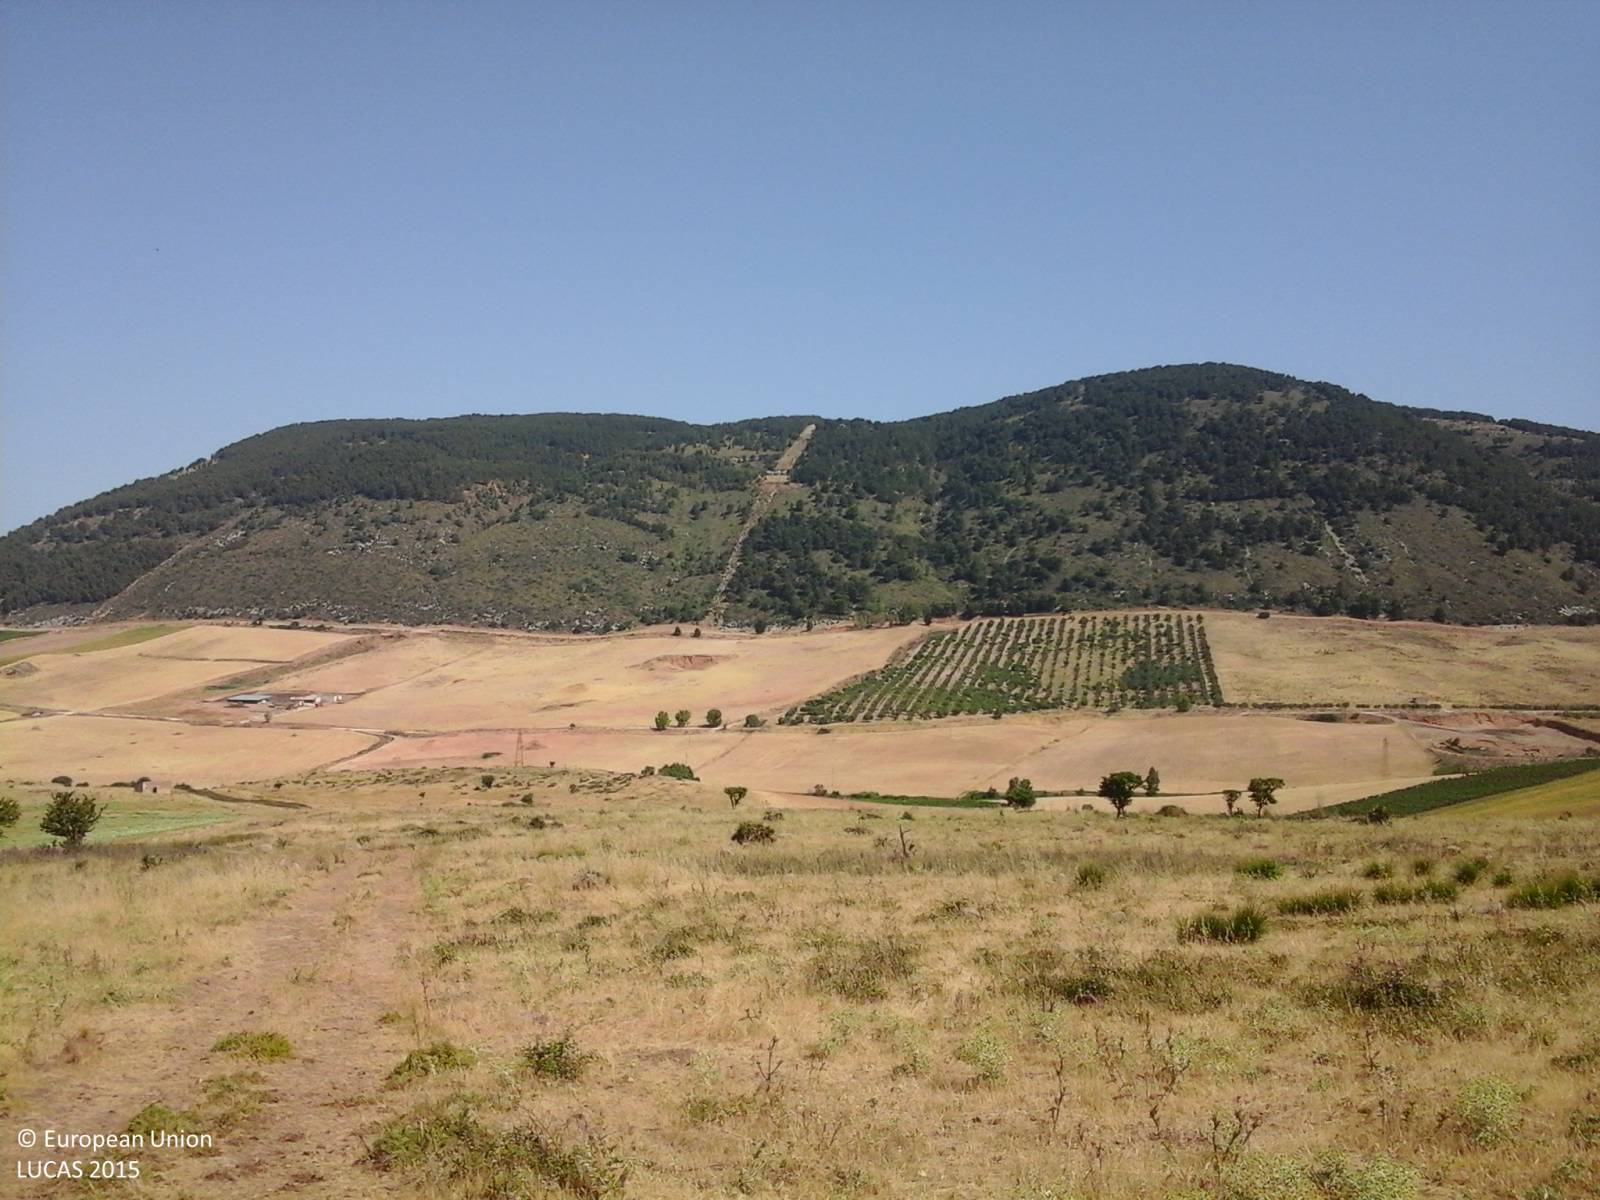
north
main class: Grassland
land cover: Grassland without tree/shrub cover
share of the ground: > 75 %
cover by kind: herbaceous plants 100 %
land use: Agriculture (excluding fallow land and kitchen gardens)
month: June
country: IT
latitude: 37.8708
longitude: 12.7648
